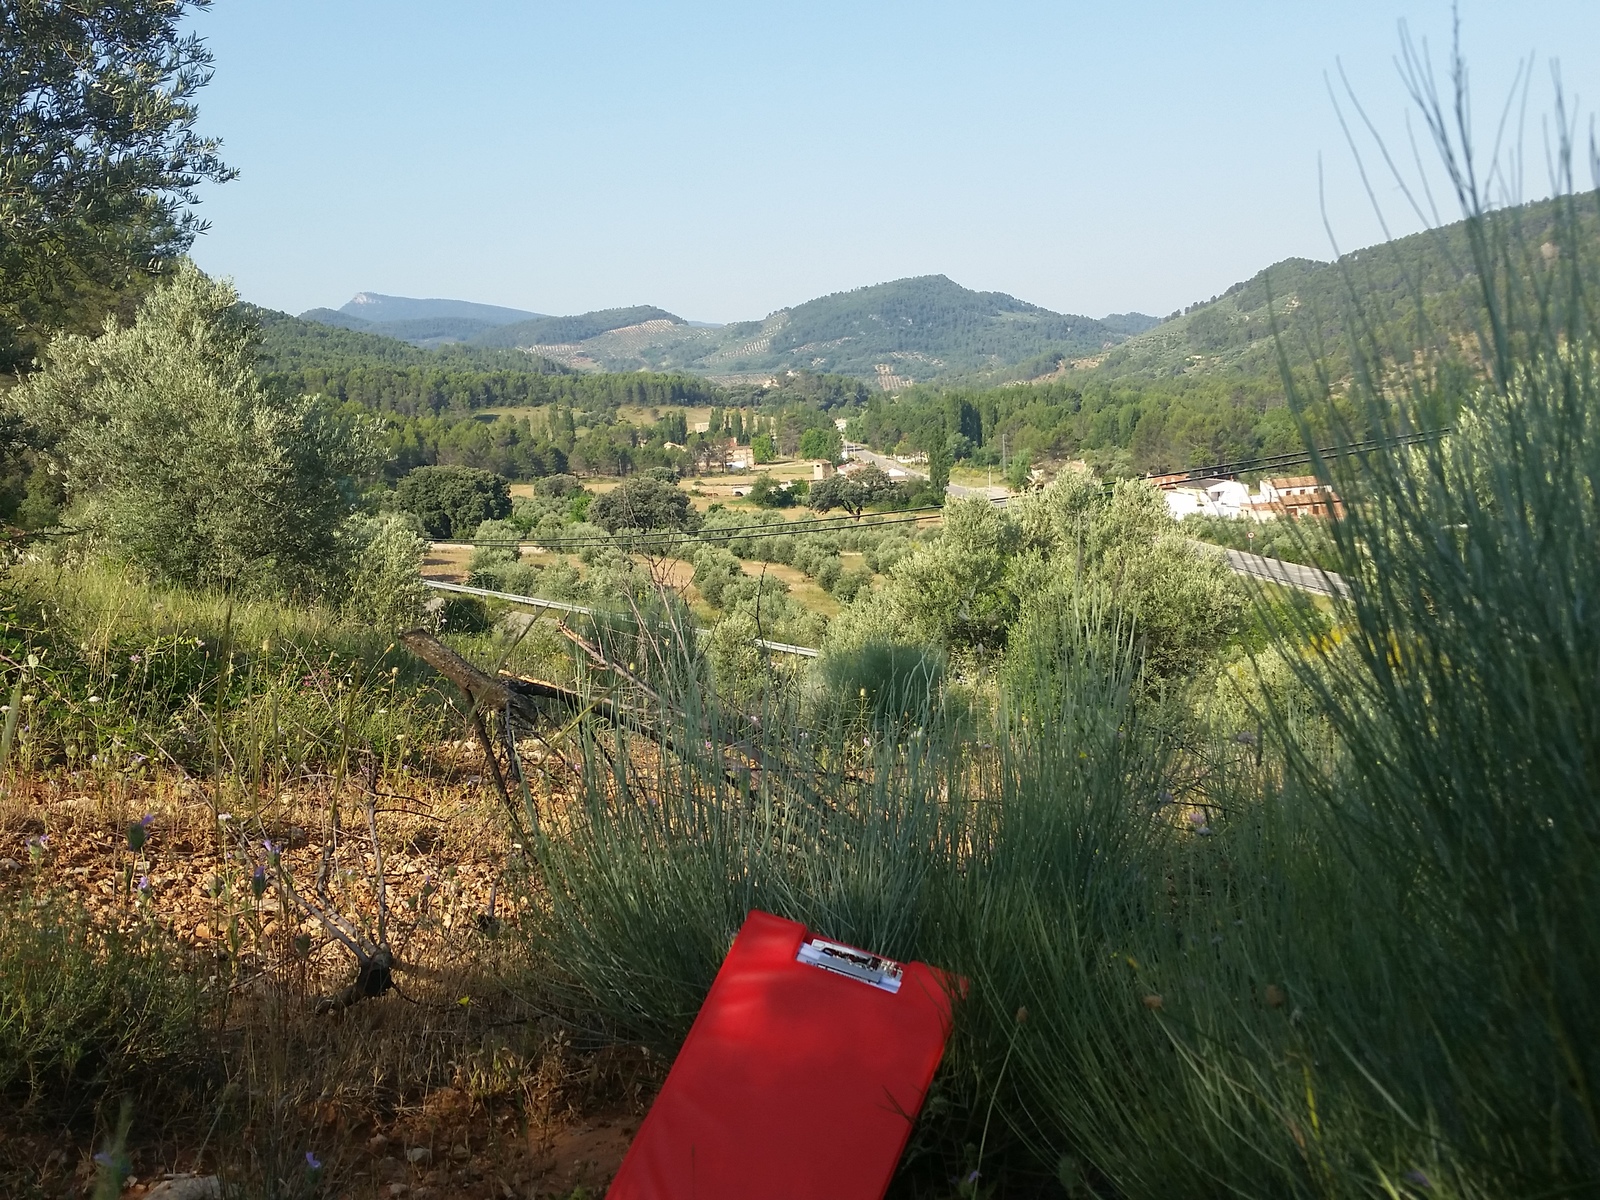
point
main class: Cropland
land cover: Olive groves
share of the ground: 25 - 50 %
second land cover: Grassland without tree/shrub cover
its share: 10 - 25 %
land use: Agriculture (excluding fallow land and kitchen gardens)
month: June
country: ES
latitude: 38.4372
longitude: -2.5202
